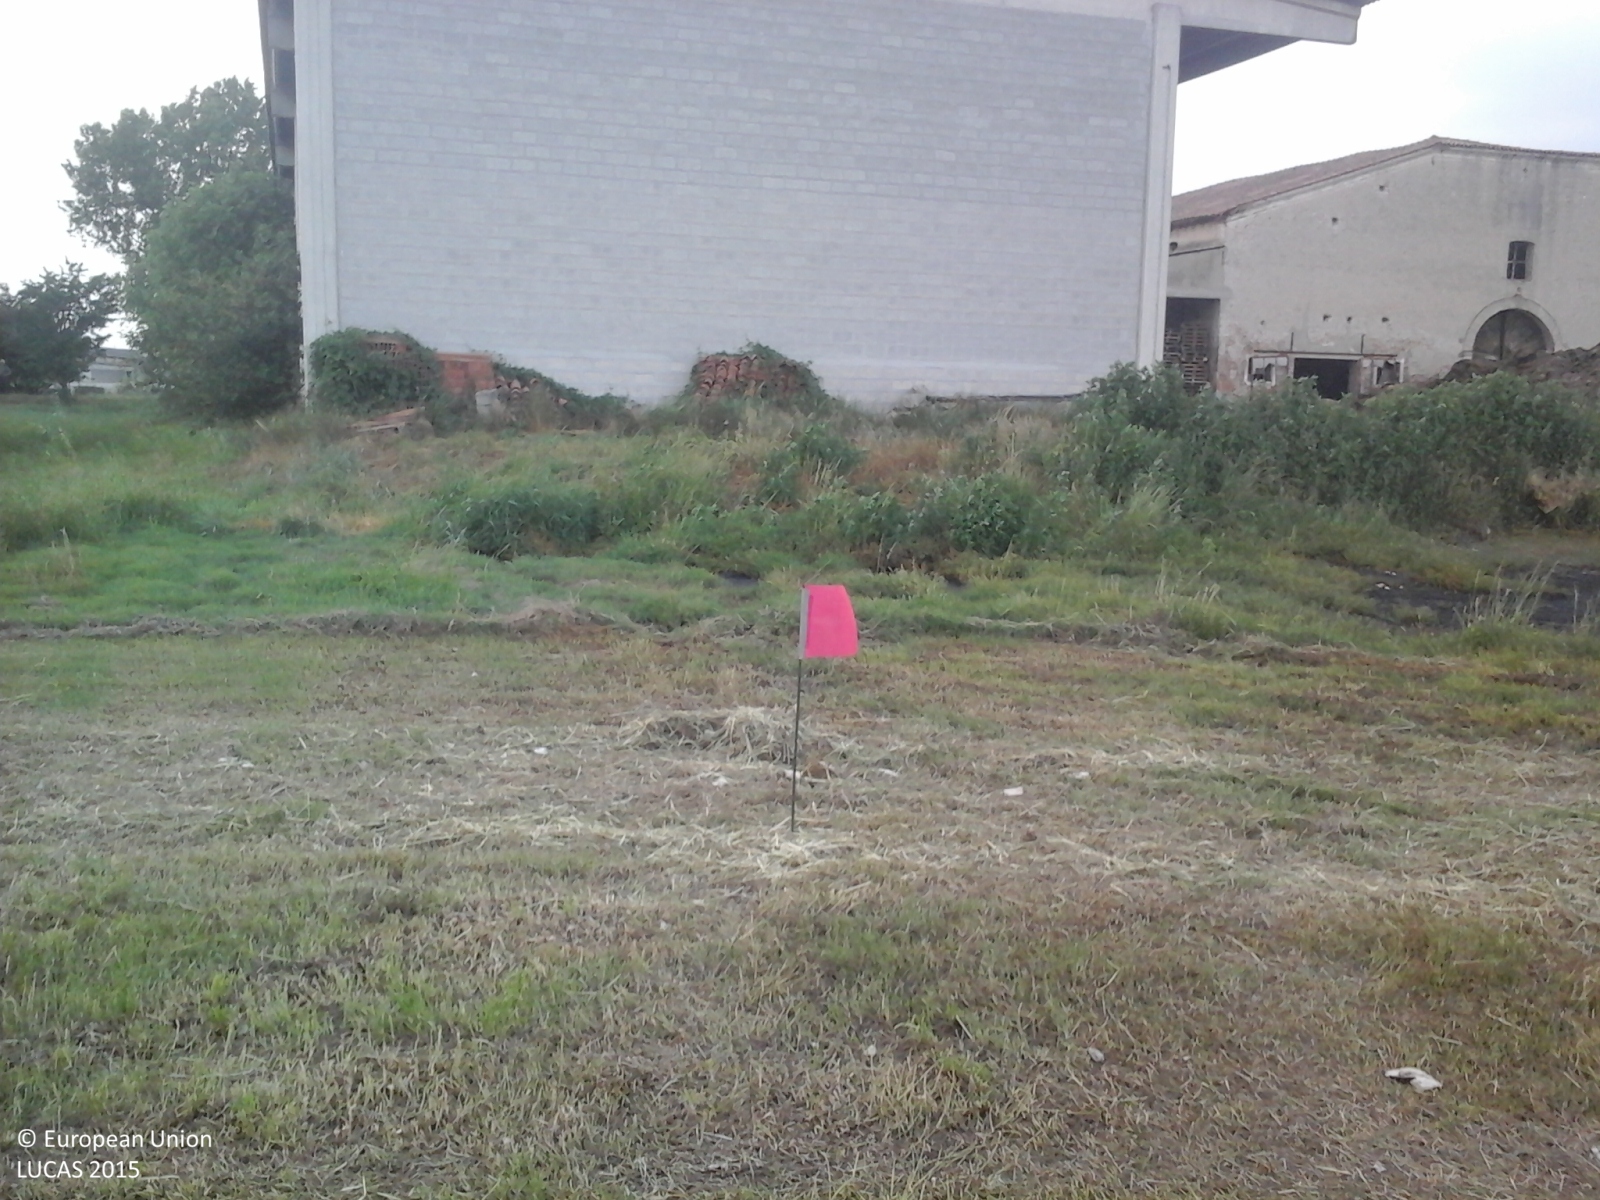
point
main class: Grassland
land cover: Grassland without tree/shrub cover
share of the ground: > 75 %
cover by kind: herbaceous plants 100 %
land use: Agriculture (excluding fallow land and kitchen gardens)
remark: Harvested field
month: May
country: IT
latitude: 45.2137
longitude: 10.6990
